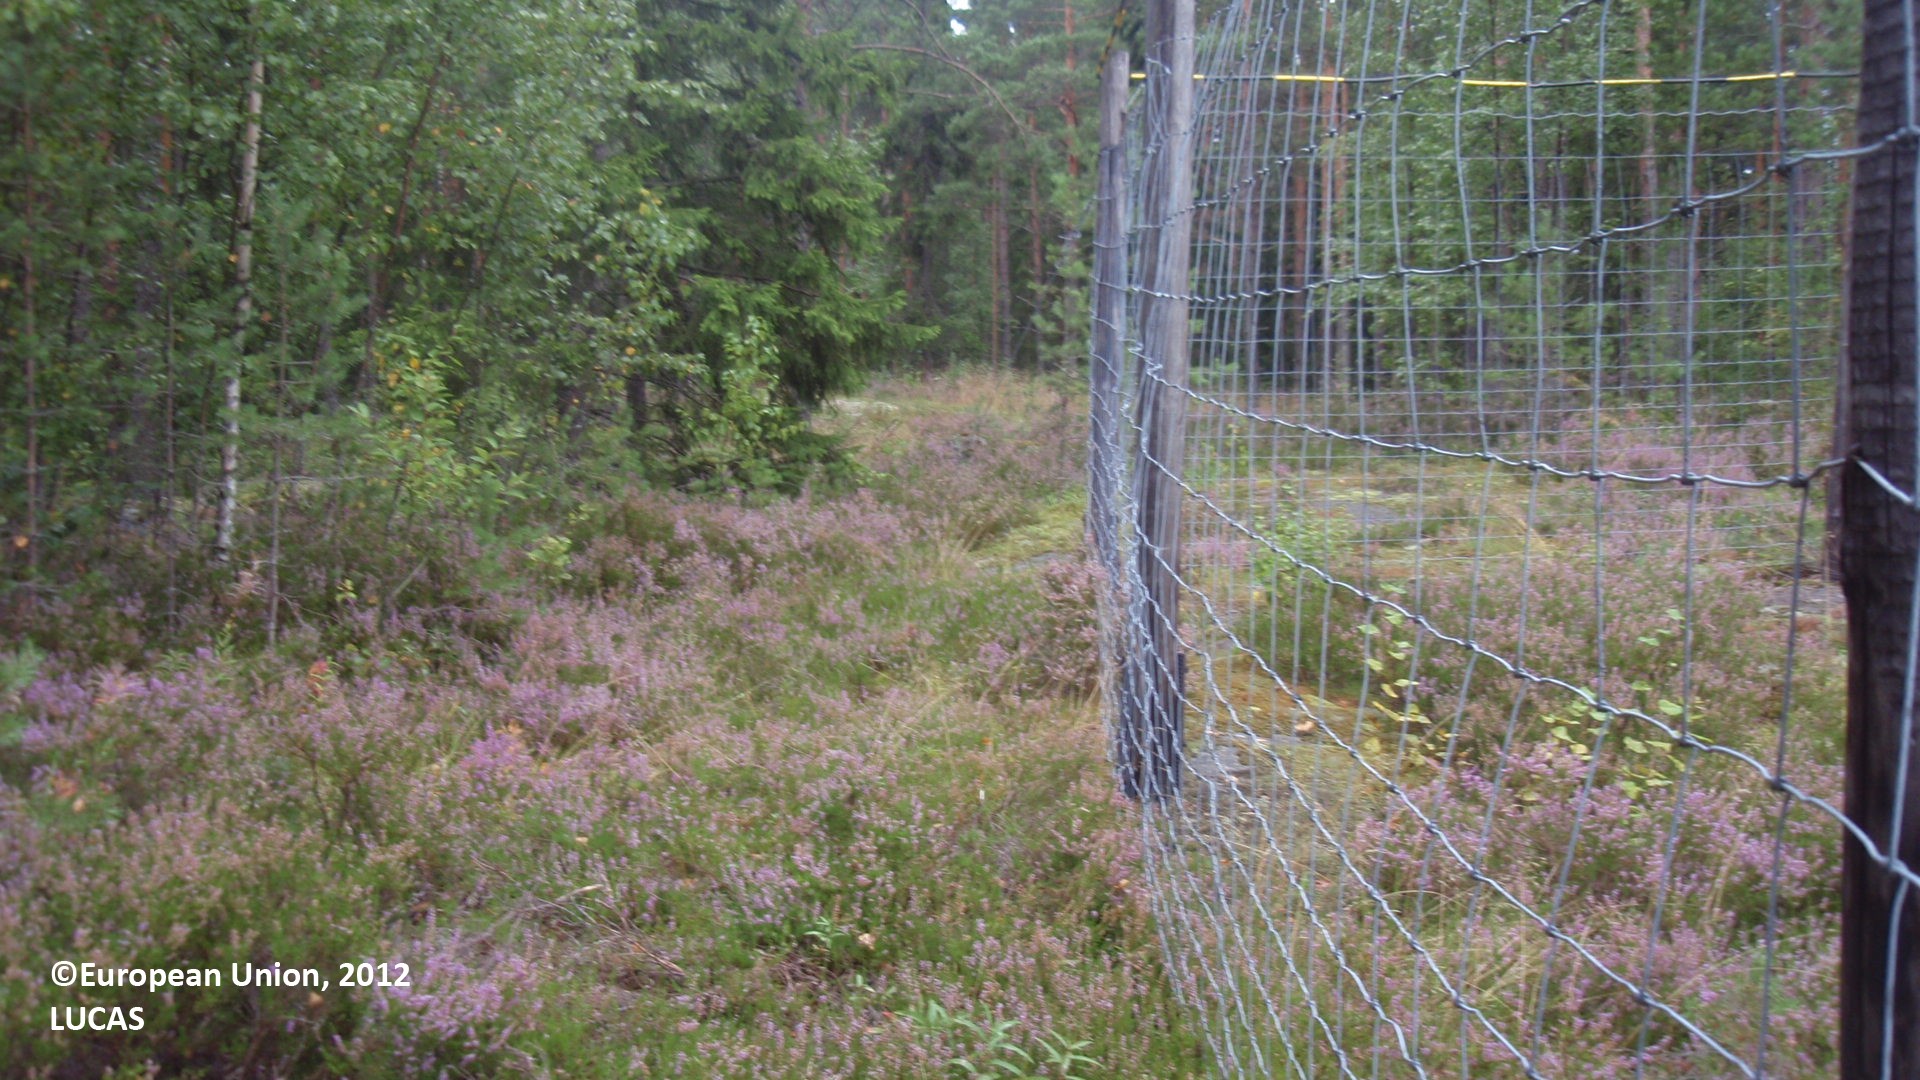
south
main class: Grassland
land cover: Grassland with sparse tree/shrub cover
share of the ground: > 75 %
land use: Abandoned areas
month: August
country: FI
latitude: 60.5683
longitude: 27.0850
